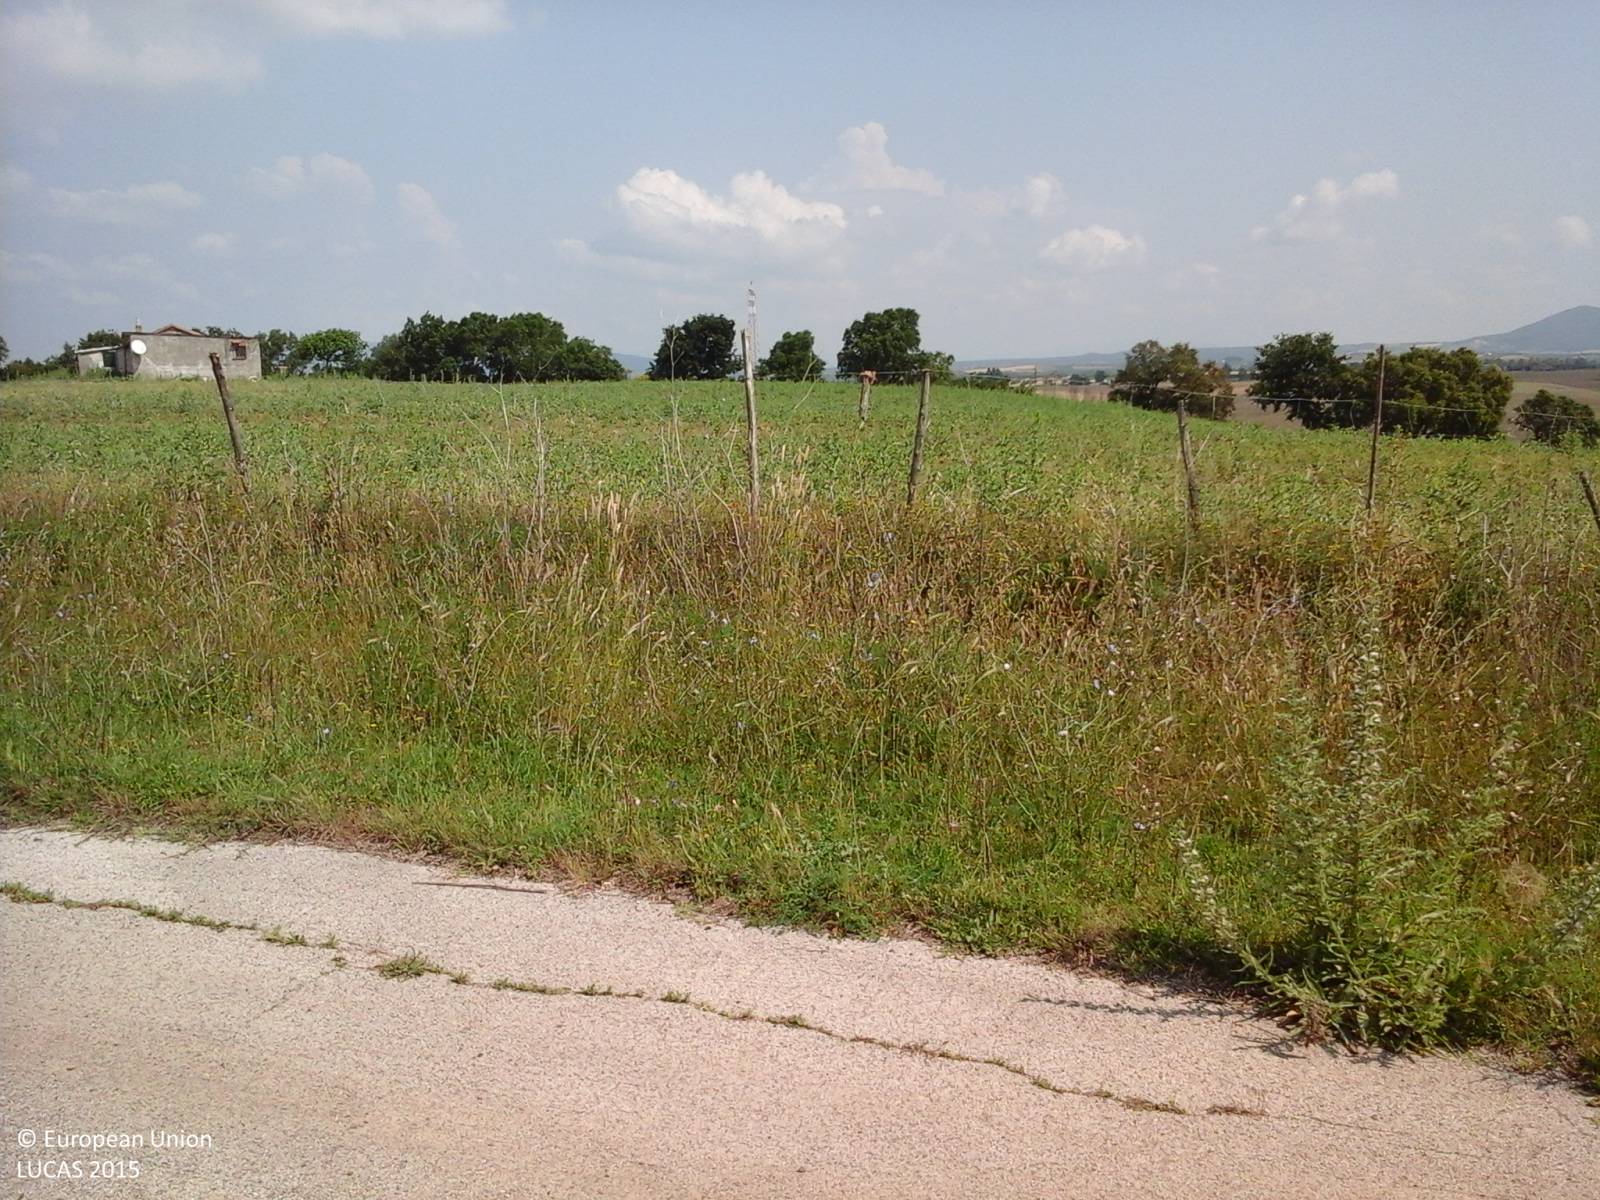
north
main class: Cropland
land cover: Oats
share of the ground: > 75 %
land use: Agriculture (excluding fallow land and kitchen gardens)
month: June
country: IT
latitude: 42.3695
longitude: 11.6578
